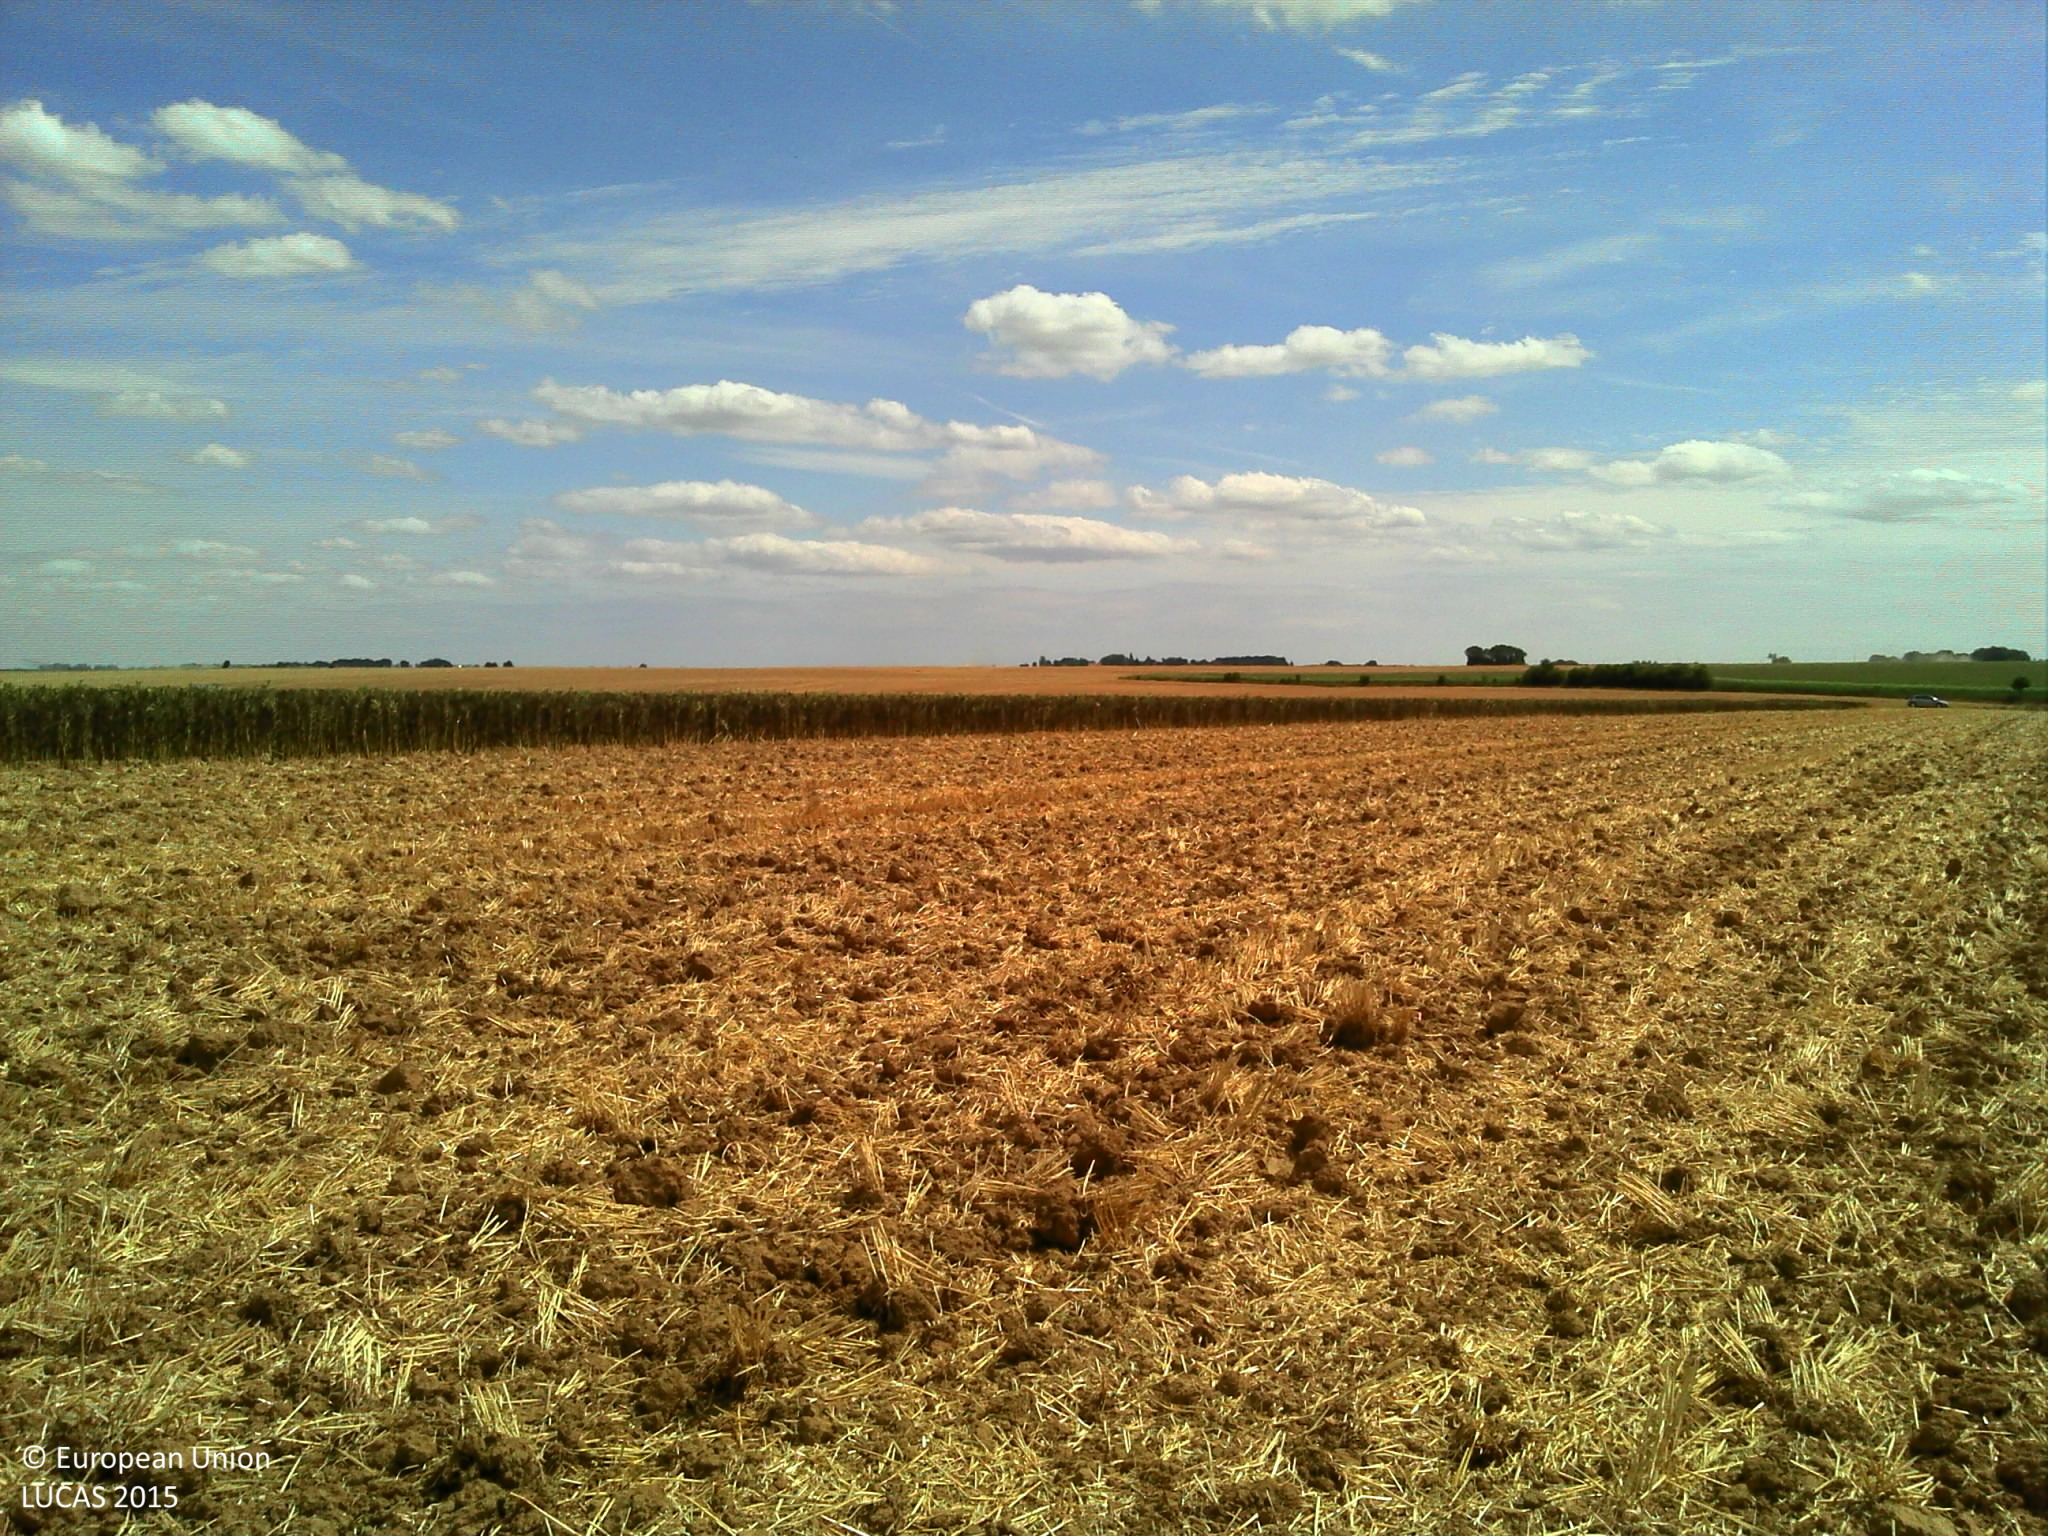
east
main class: Cropland
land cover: Barley
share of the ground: > 75 %
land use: Agriculture (excluding fallow land and kitchen gardens)
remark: Harvested field
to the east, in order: Barley; Rape and turnip rape
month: July
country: FR
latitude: 49.0951
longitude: 2.8827
